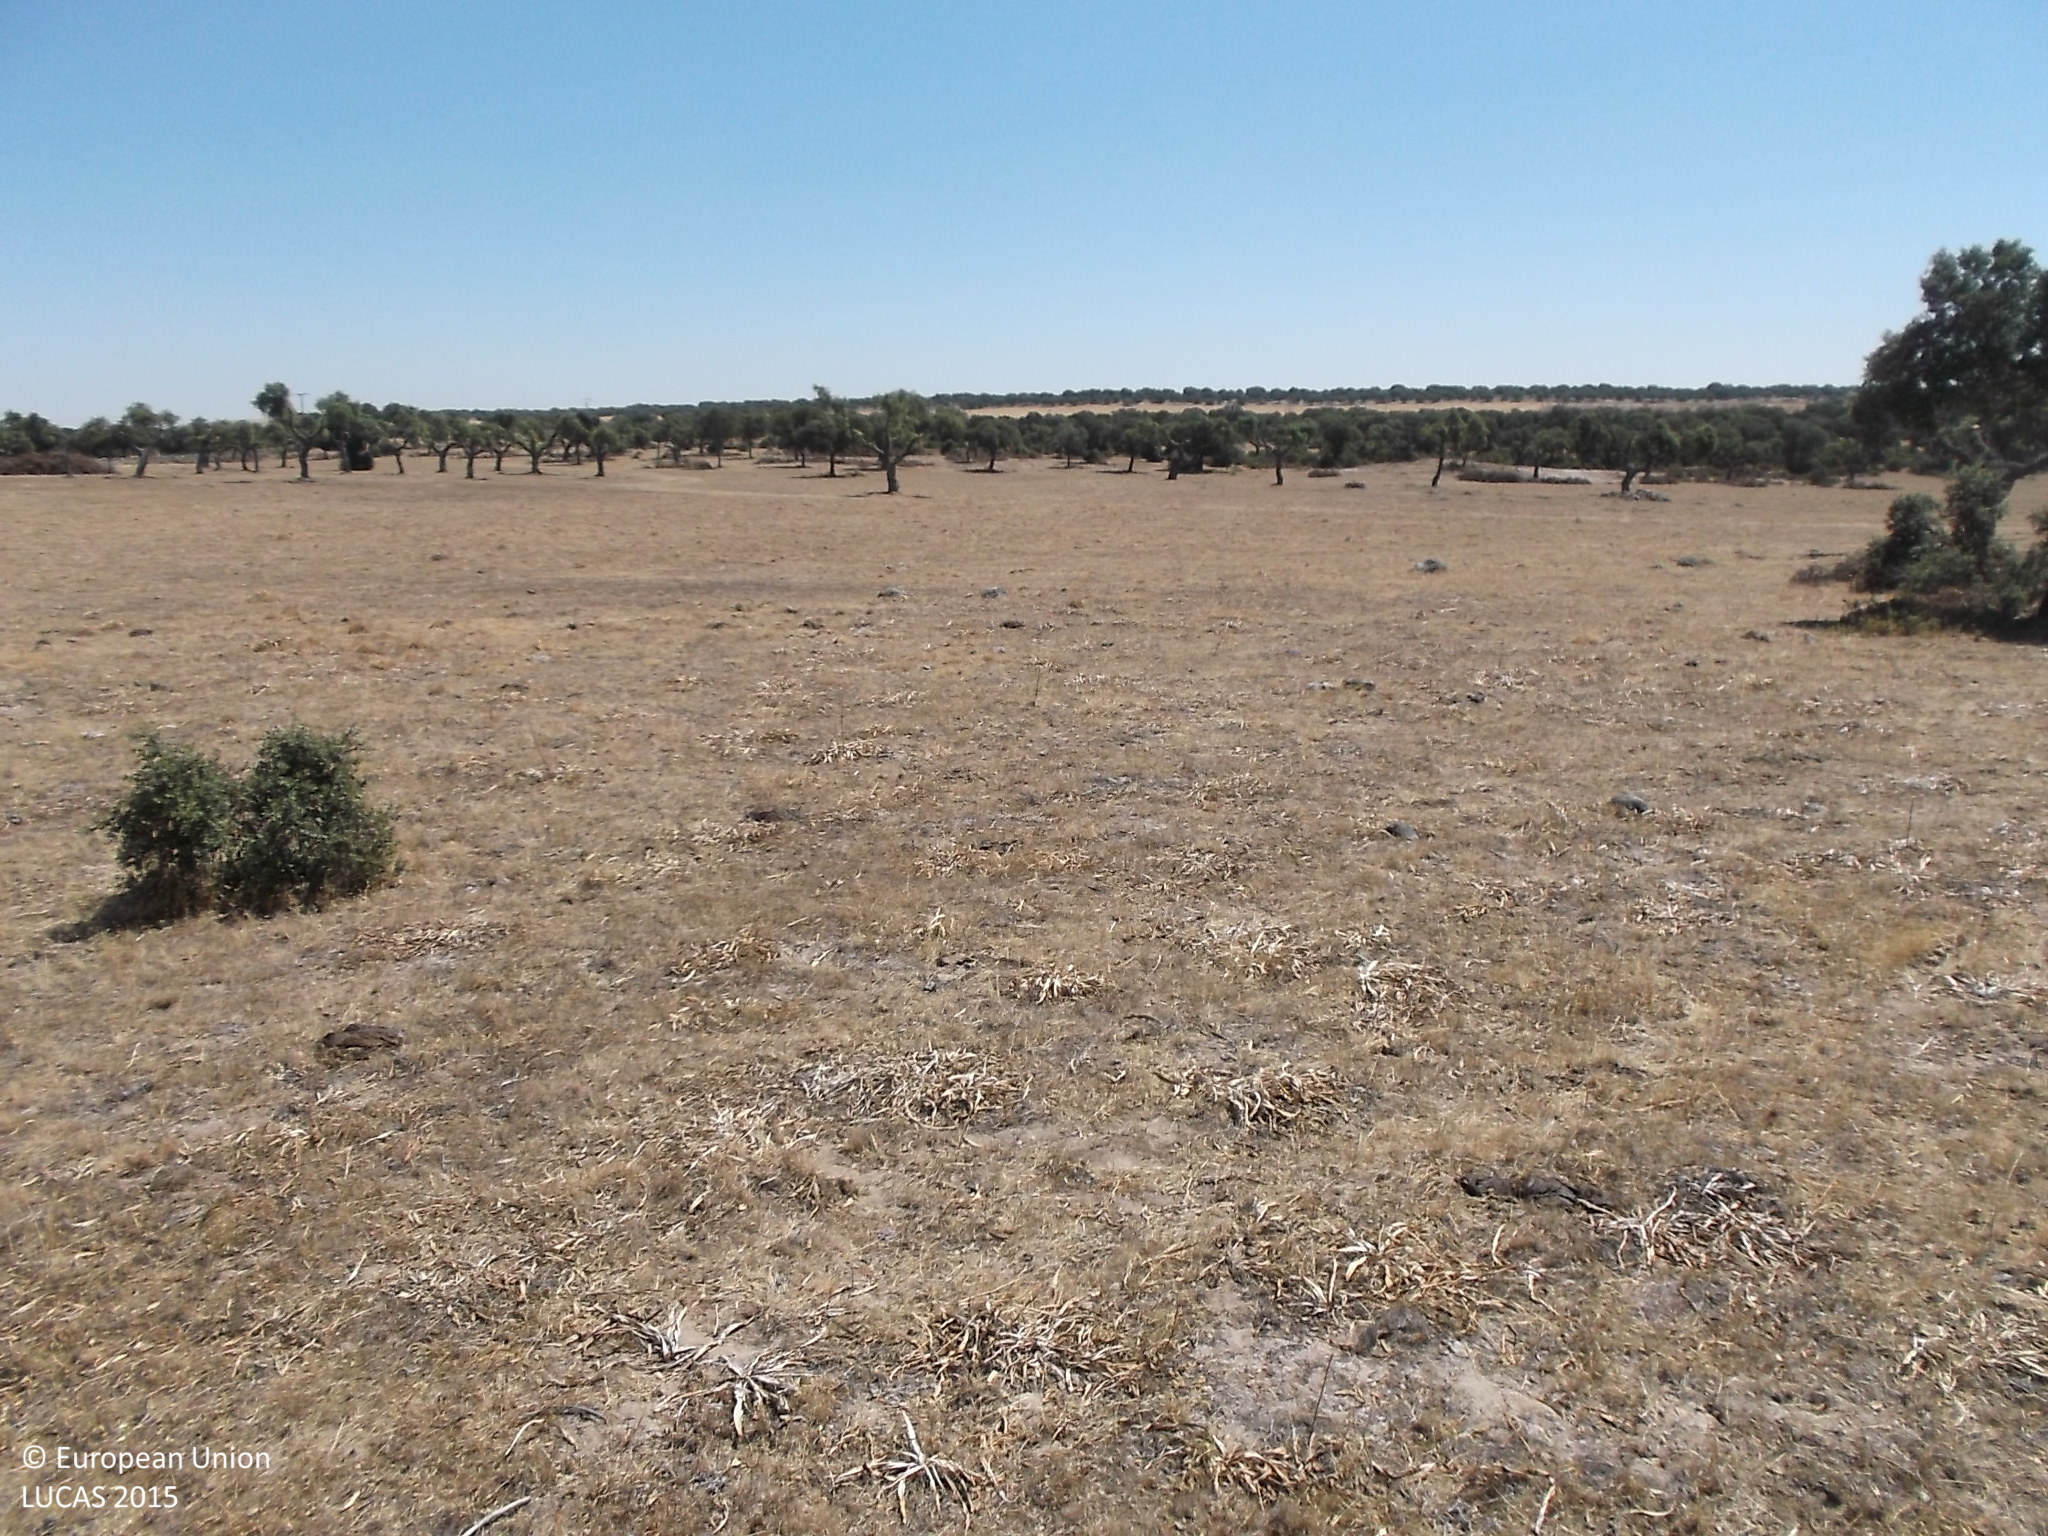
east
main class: Woodland
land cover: Broadleaved woodland
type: broadleaved evergreen forest
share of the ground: 10 - 25 %
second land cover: Grassland without tree/shrub cover
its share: > 75 %
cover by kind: herbaceous plants 80 %, broadleaved forest trees 20 %
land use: Forestry
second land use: Agriculture (excluding fallow land and kitchen gardens)
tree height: < 5 m
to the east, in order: Broadleaved woodland; Grassland without tree/shrub cover; Single bushes/trees; Grassland without tree/shrub cover; Broadleaved woodland
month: July
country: ES
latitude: 41.3456
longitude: -5.8255
